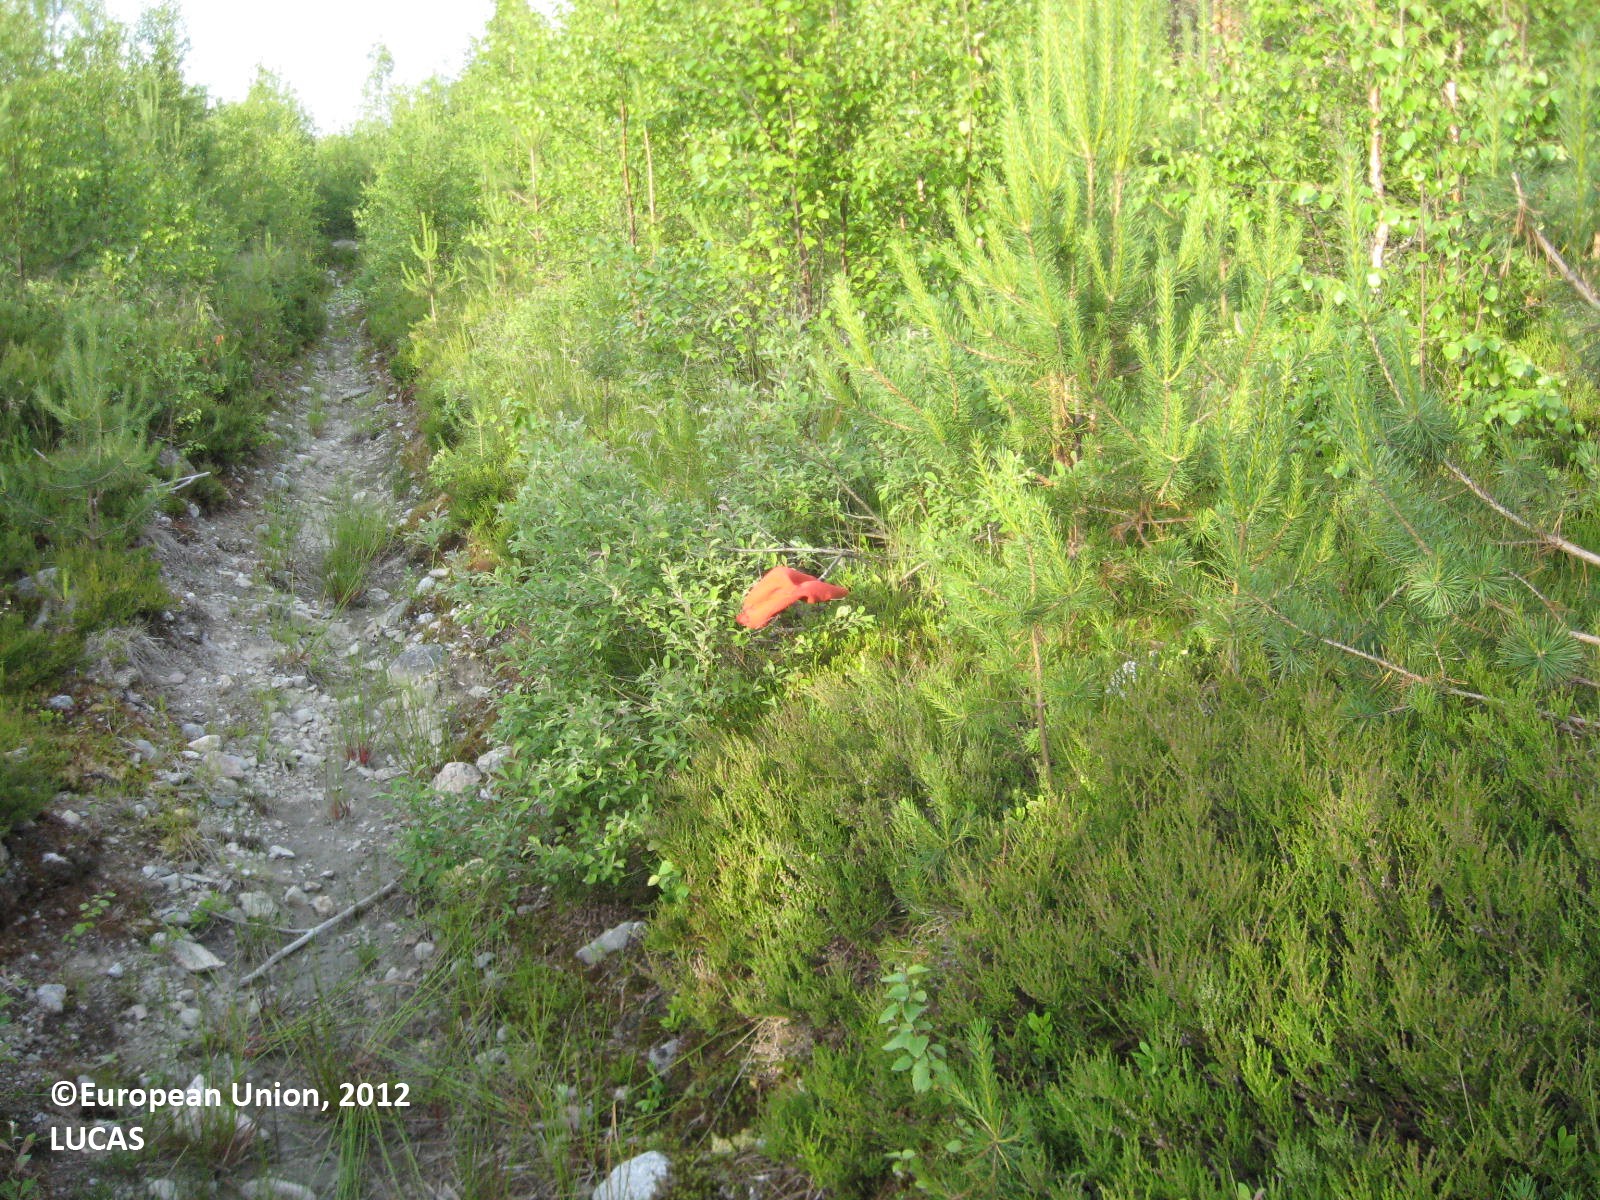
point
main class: Woodland
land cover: Pine dominated mixed woodland
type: boreal forest
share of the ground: > 75 %
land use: Forestry
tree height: < 5 m
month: July
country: FI
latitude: 62.5538
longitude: 21.7336
